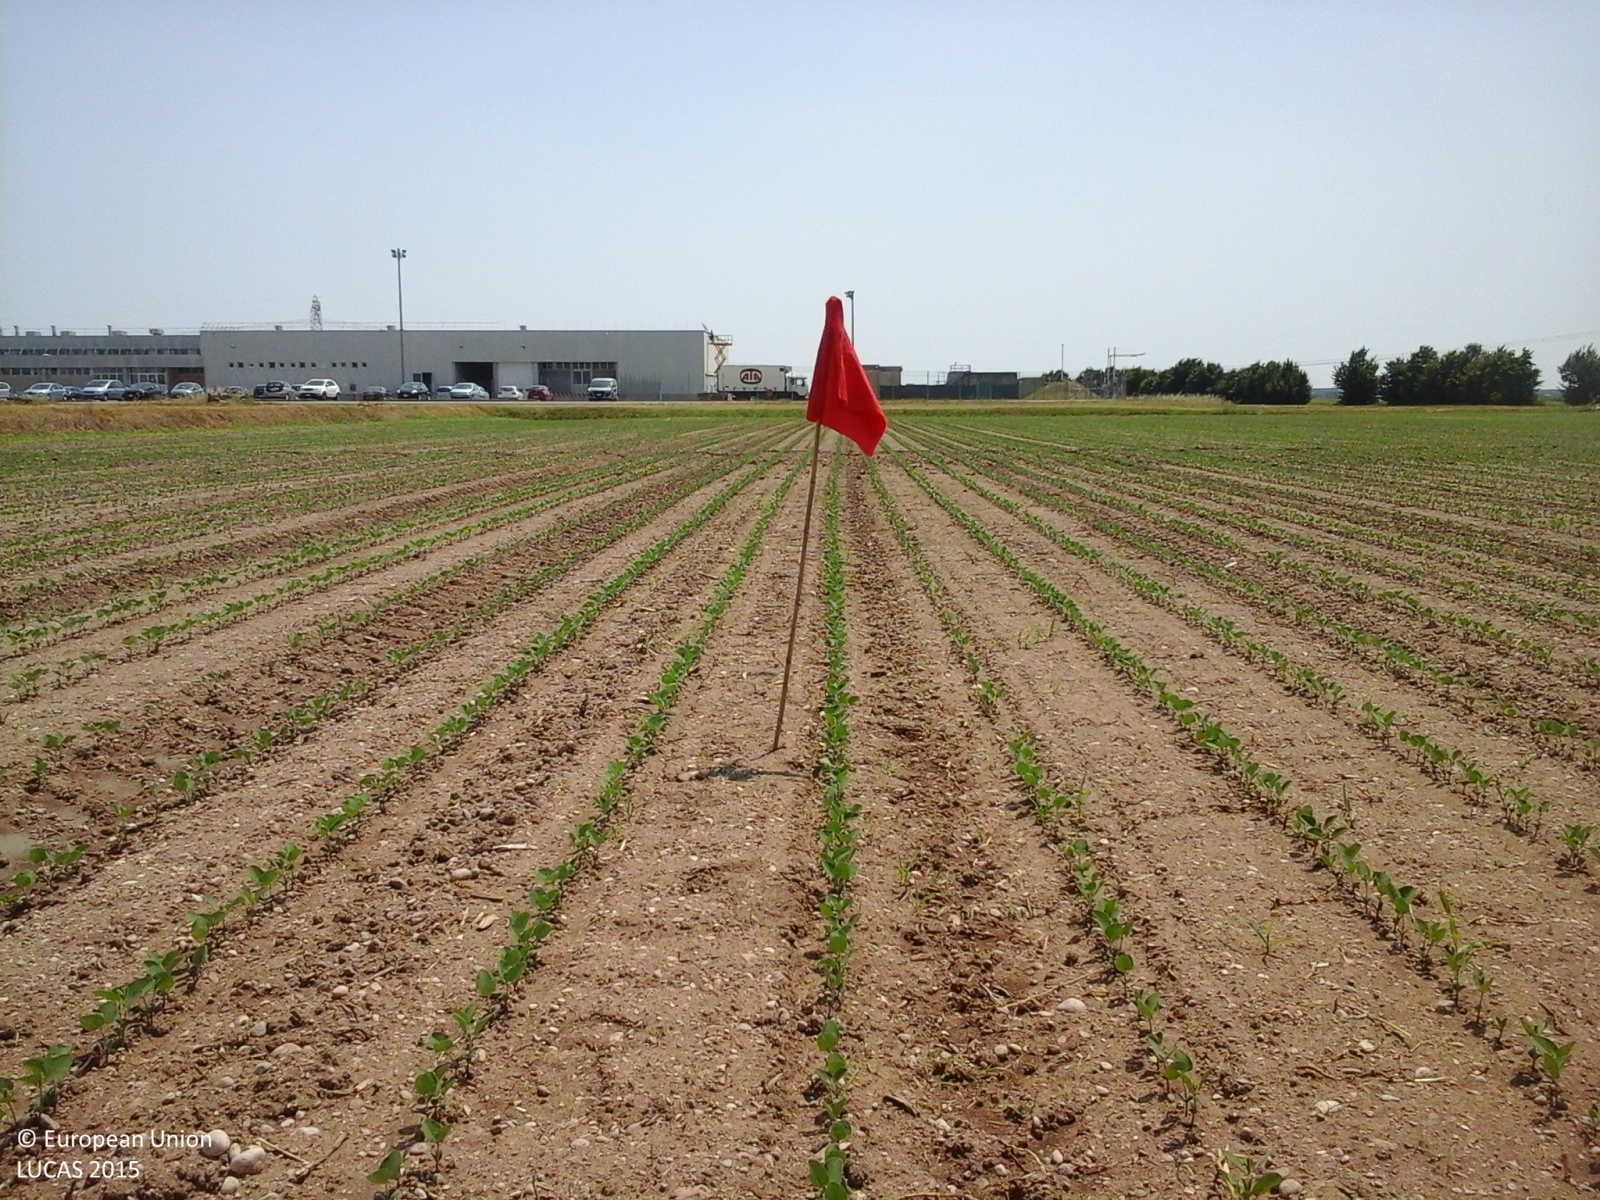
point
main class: Cropland
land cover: Soya
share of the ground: < 10 %
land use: Agriculture (excluding fallow land and kitchen gardens)
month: July
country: IT
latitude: 45.3196
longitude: 10.9805
